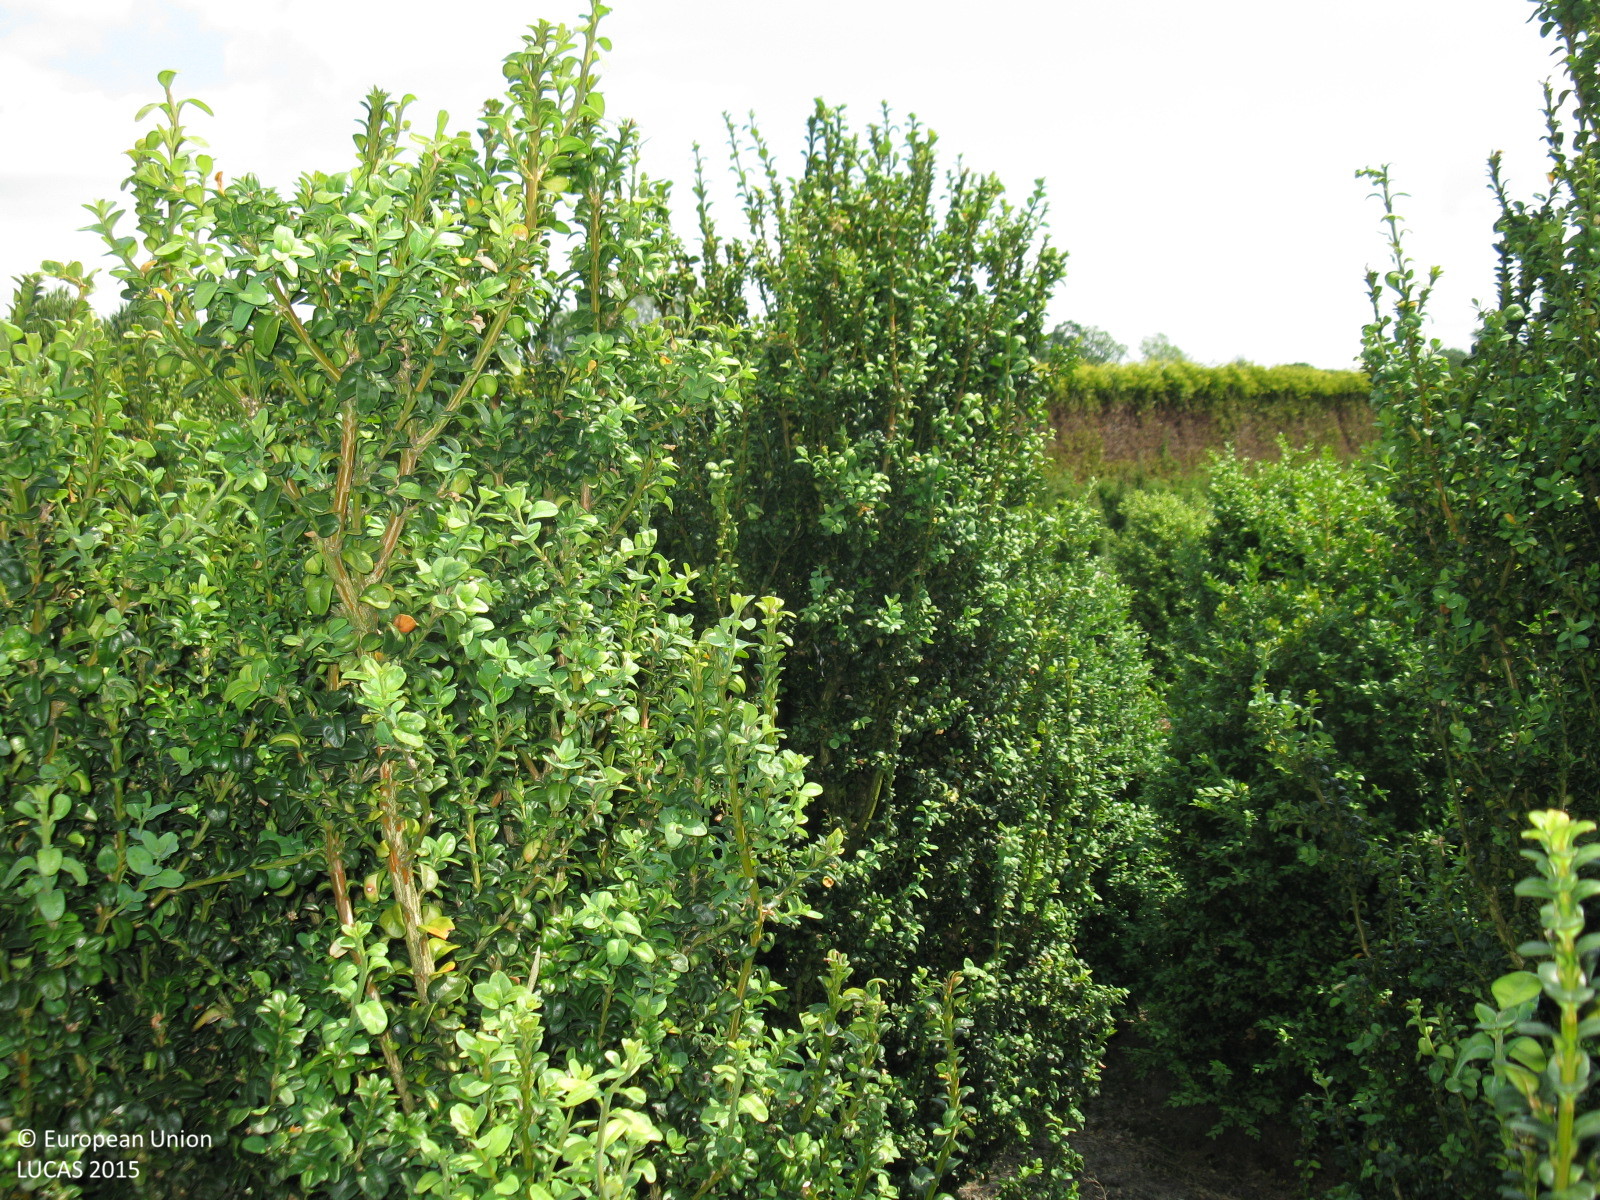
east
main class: Cropland
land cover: Nurseries
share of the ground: > 75 %
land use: Agriculture (excluding fallow land and kitchen gardens)
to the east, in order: Nurseries; Tracks; Nurseries; Conifer hedges; Fences; Grassland without tree/shrub cover; Fences; Shrubland without tree cover; Ditches and canals; Lines of trees; Paved roads, cycling and walking lanes; Spruce dominated mixed woodland; Broadleaved woodland
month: July
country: DE
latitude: 53.3300
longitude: 7.9135
